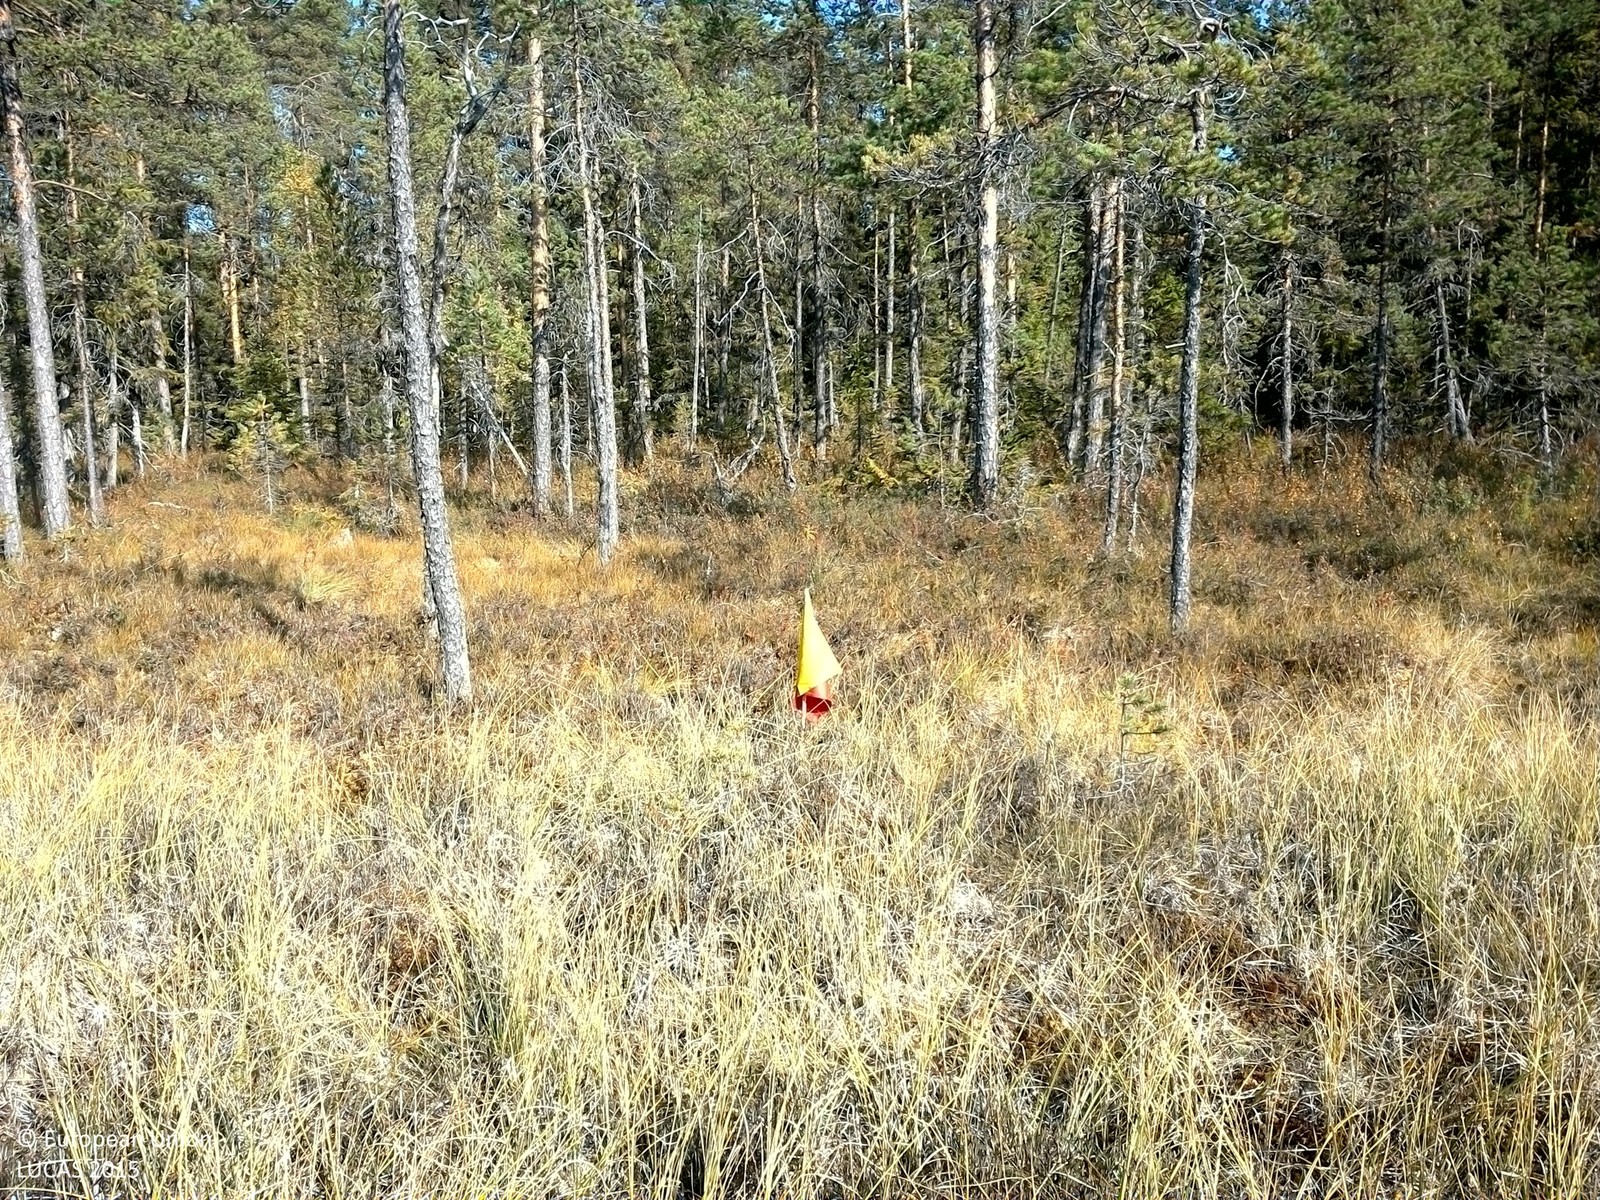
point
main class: Woodland
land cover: Pine dominated coniferous woodland
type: mire and swamp forests
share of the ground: 10 - 25 %
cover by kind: shrubs 35 %, herbaceous plants 35 %, coniferous forest trees 15 %, lichens and mosses 15 %
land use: Semi-natural and natural areas not in use
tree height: < 5 m
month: September
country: SE
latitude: 63.9592
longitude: 16.4431
